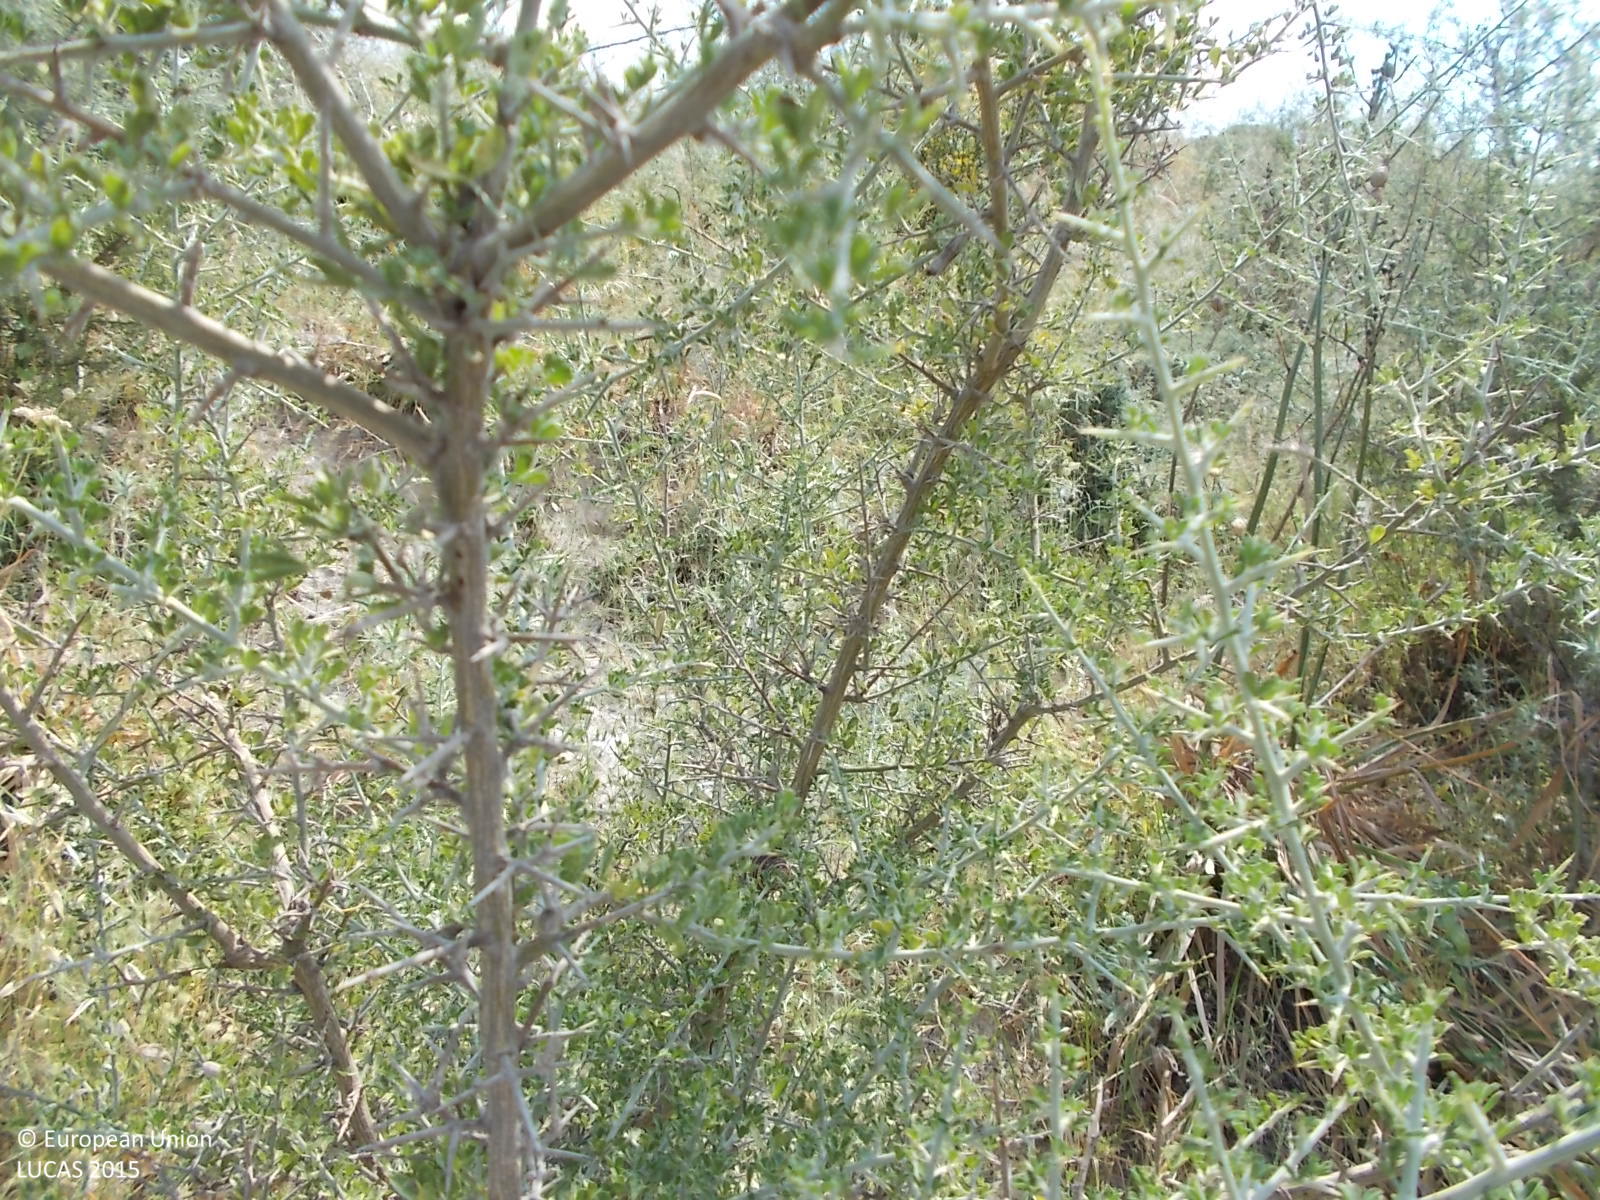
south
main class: Shrubland
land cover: Shrubland without tree cover
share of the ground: > 75 %
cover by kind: shrubs 80 %, herbaceous plants 10 %, unconsolidated bare surface 10 %
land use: Semi-natural and natural areas not in use
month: May
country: CY
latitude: 34.8879
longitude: 33.5075
